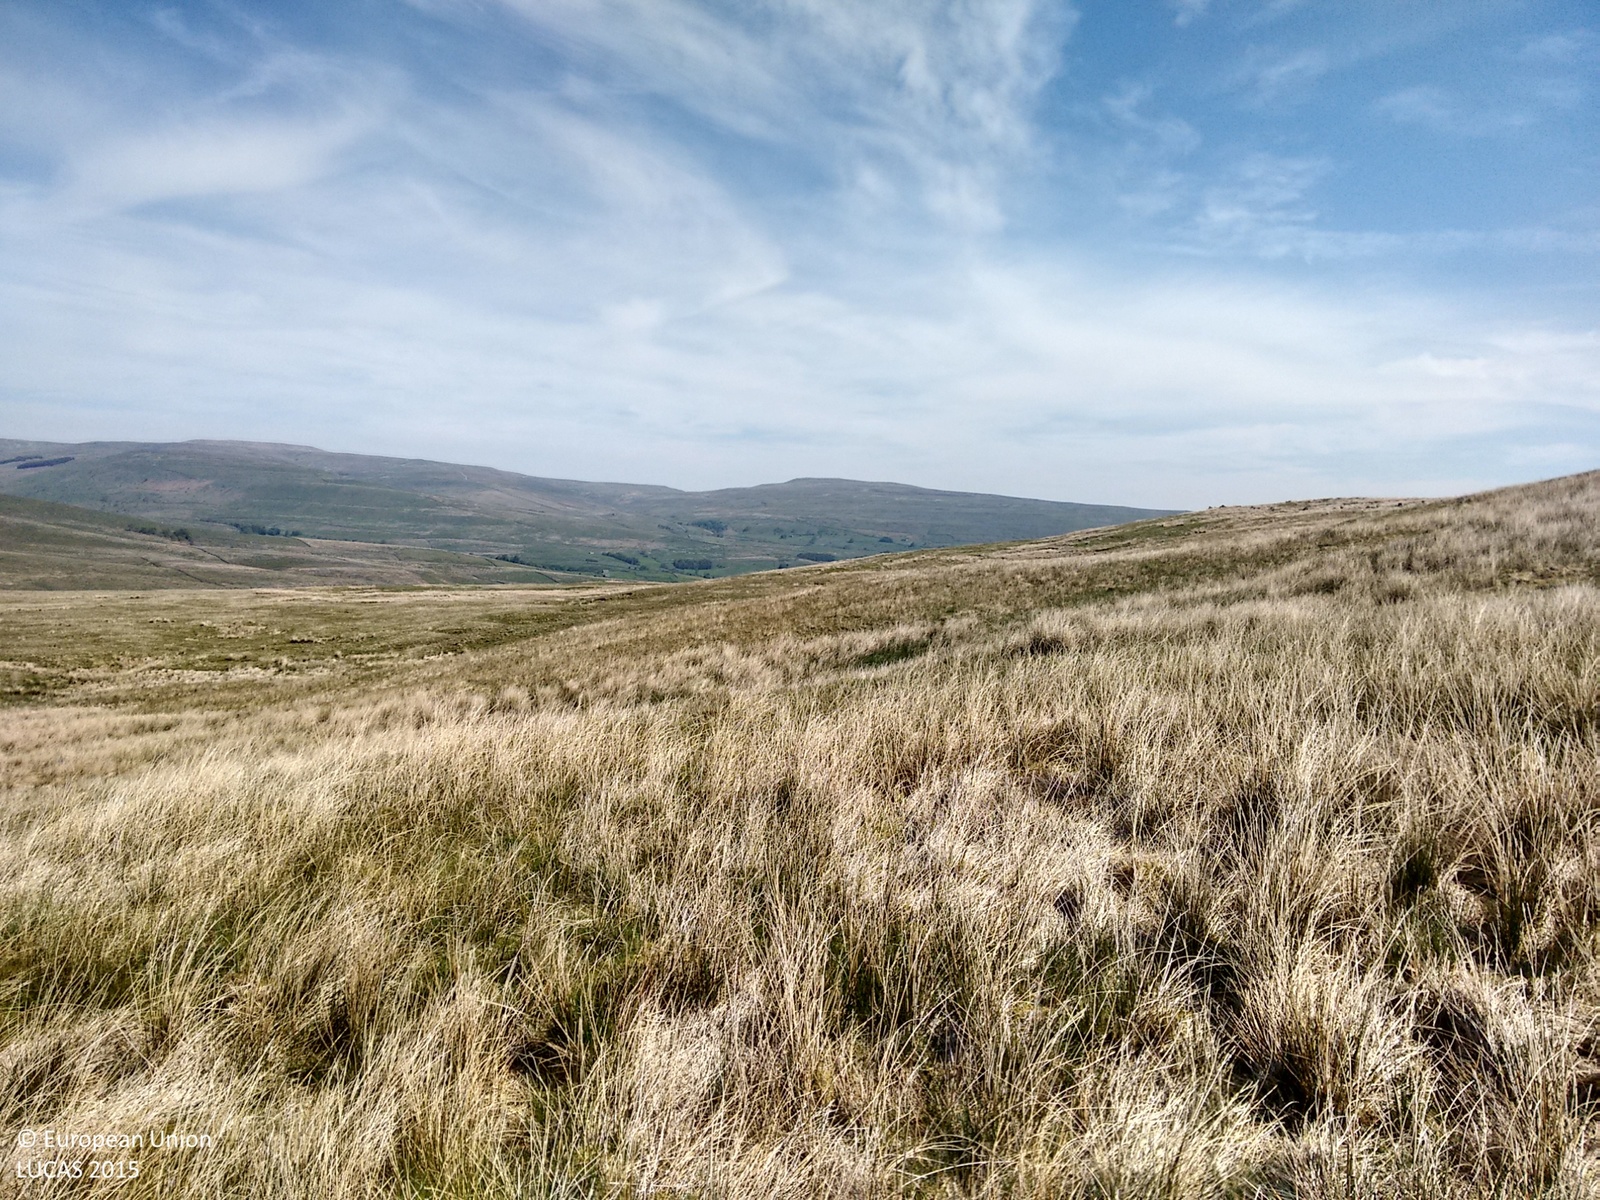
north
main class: Grassland
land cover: Grassland without tree/shrub cover
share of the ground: > 75 %
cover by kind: herbaceous plants 100 %
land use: Agriculture (excluding fallow land and kitchen gardens)
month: June
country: GB
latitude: 54.2882
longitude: -2.2421
